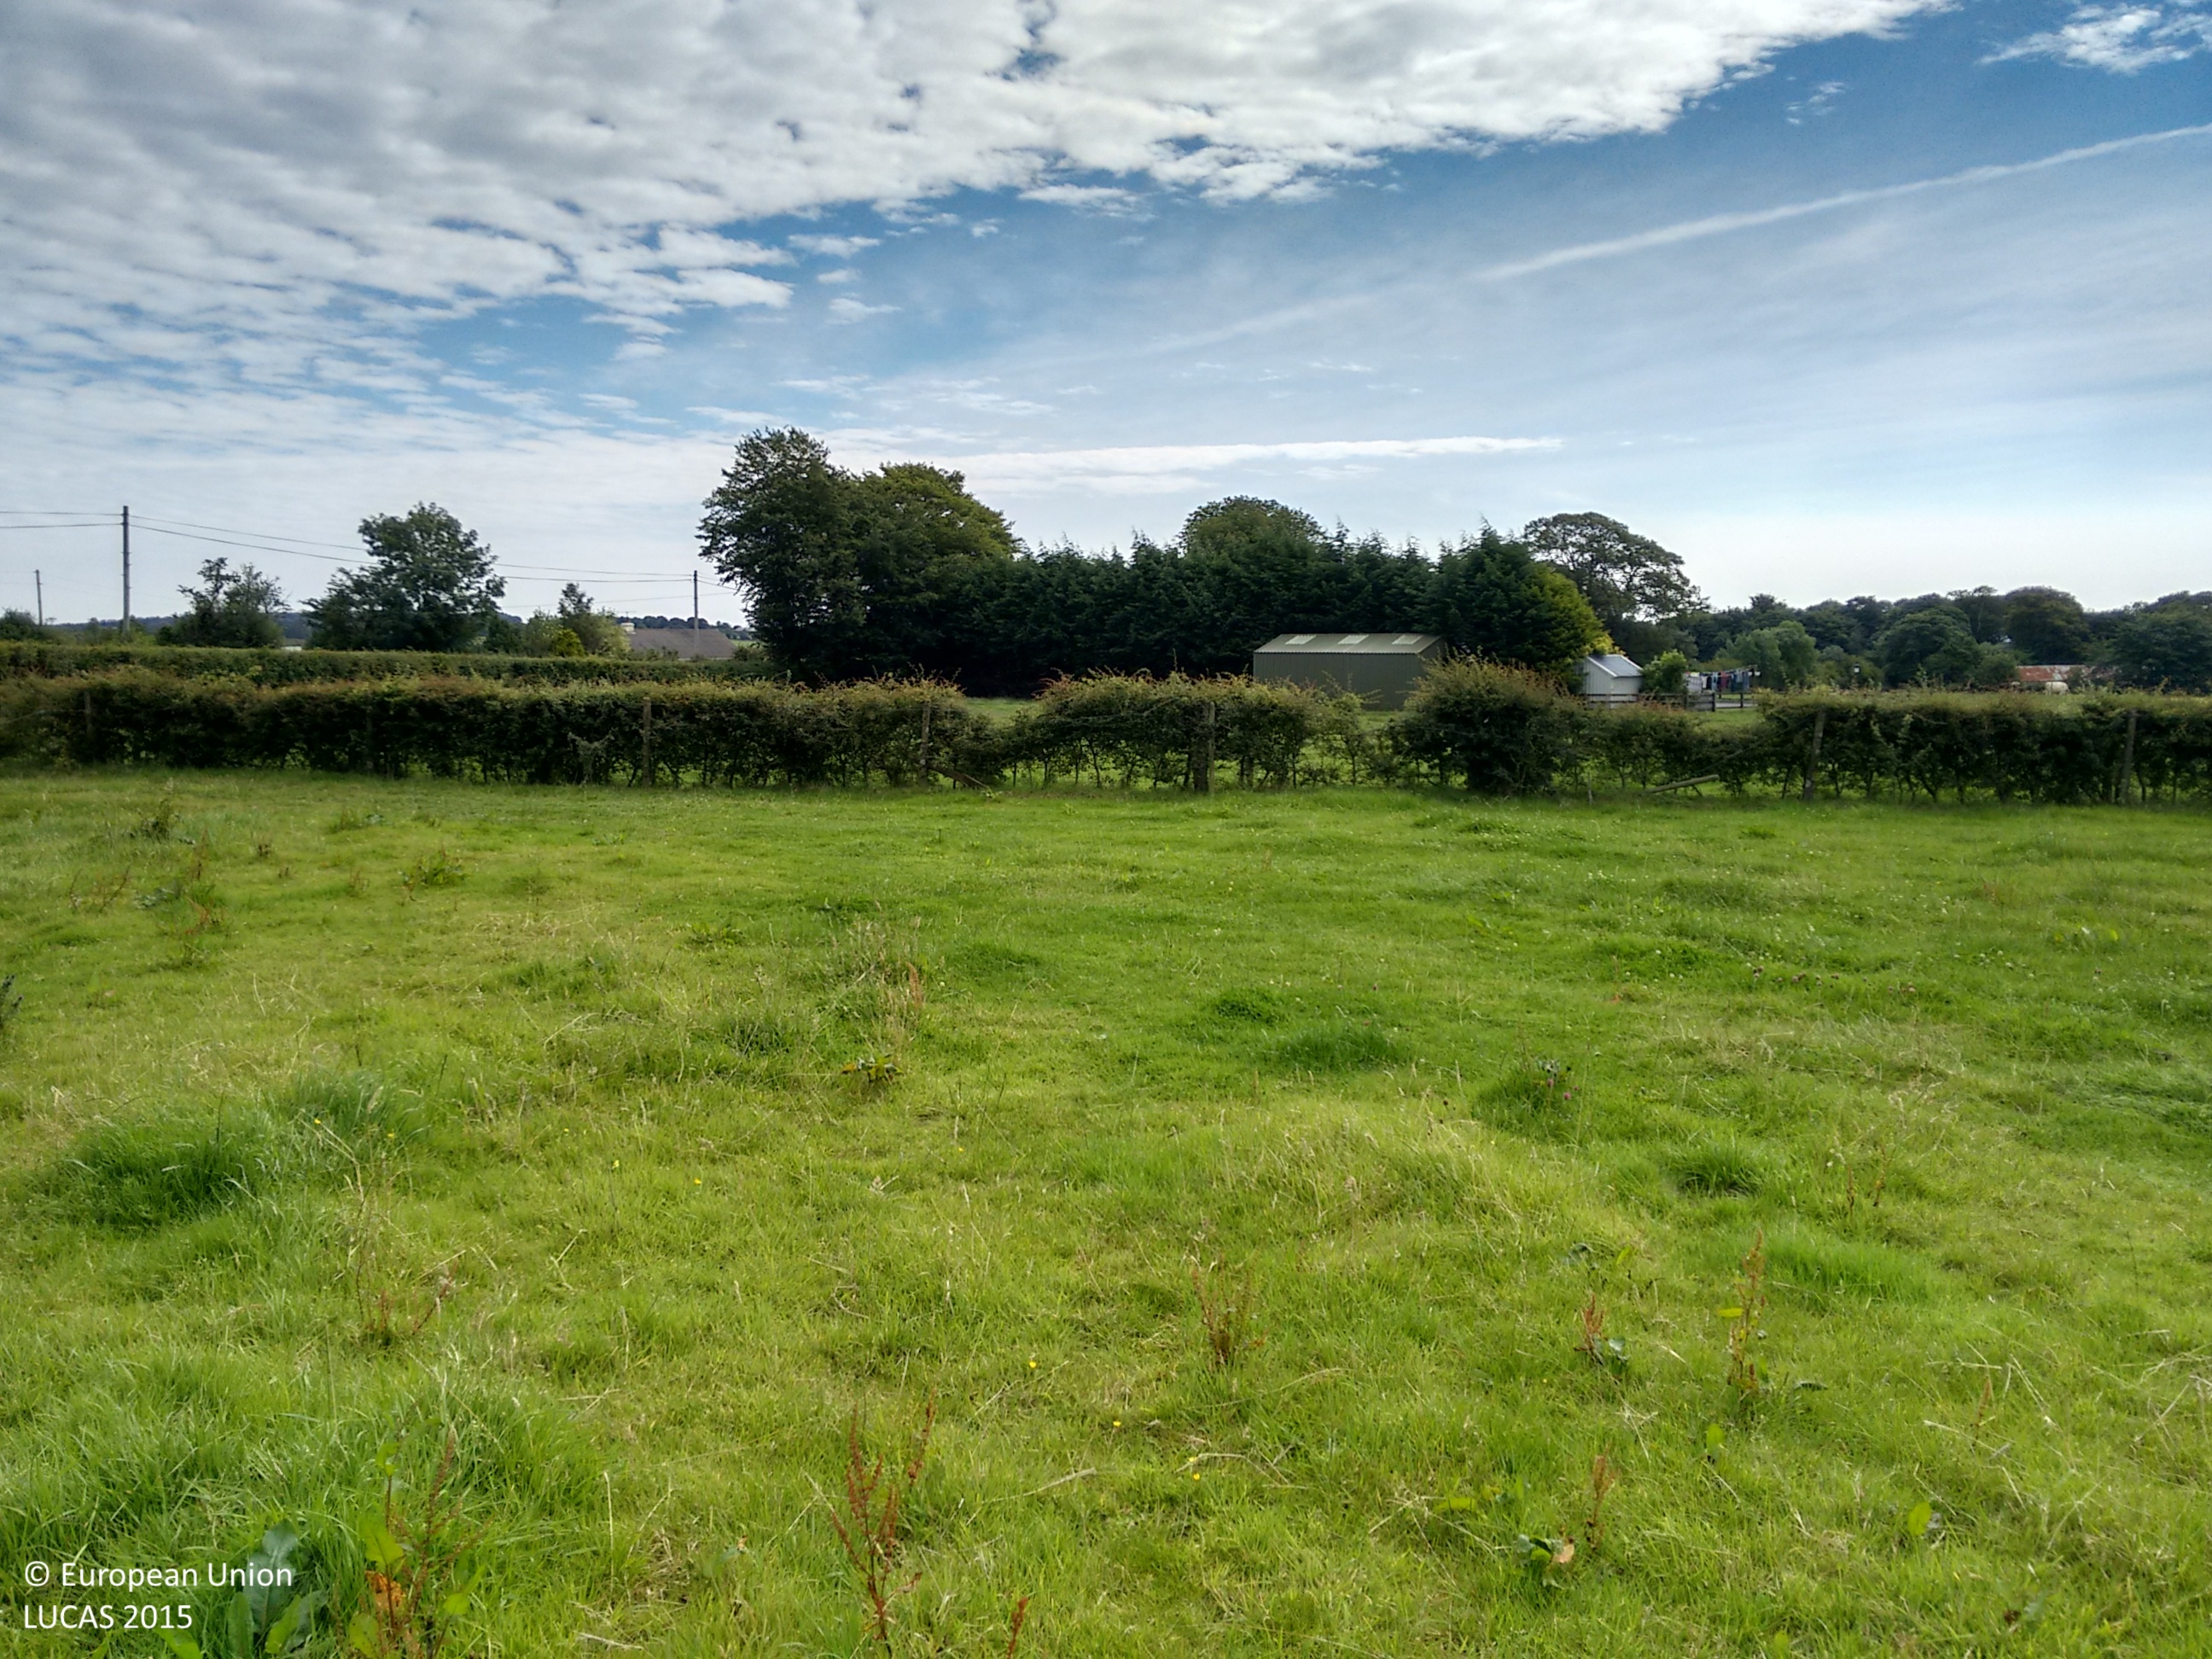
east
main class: Grassland
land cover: Grassland without tree/shrub cover
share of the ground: > 75 %
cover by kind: herbaceous plants 100 %
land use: Agriculture (excluding fallow land and kitchen gardens)
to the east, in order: Grassland without tree/shrub cover; Fences; Managed hedges; Grassland without tree/shrub cover; Artificial constructions in urban areas
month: August
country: IE
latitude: 53.0295
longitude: -7.5306
